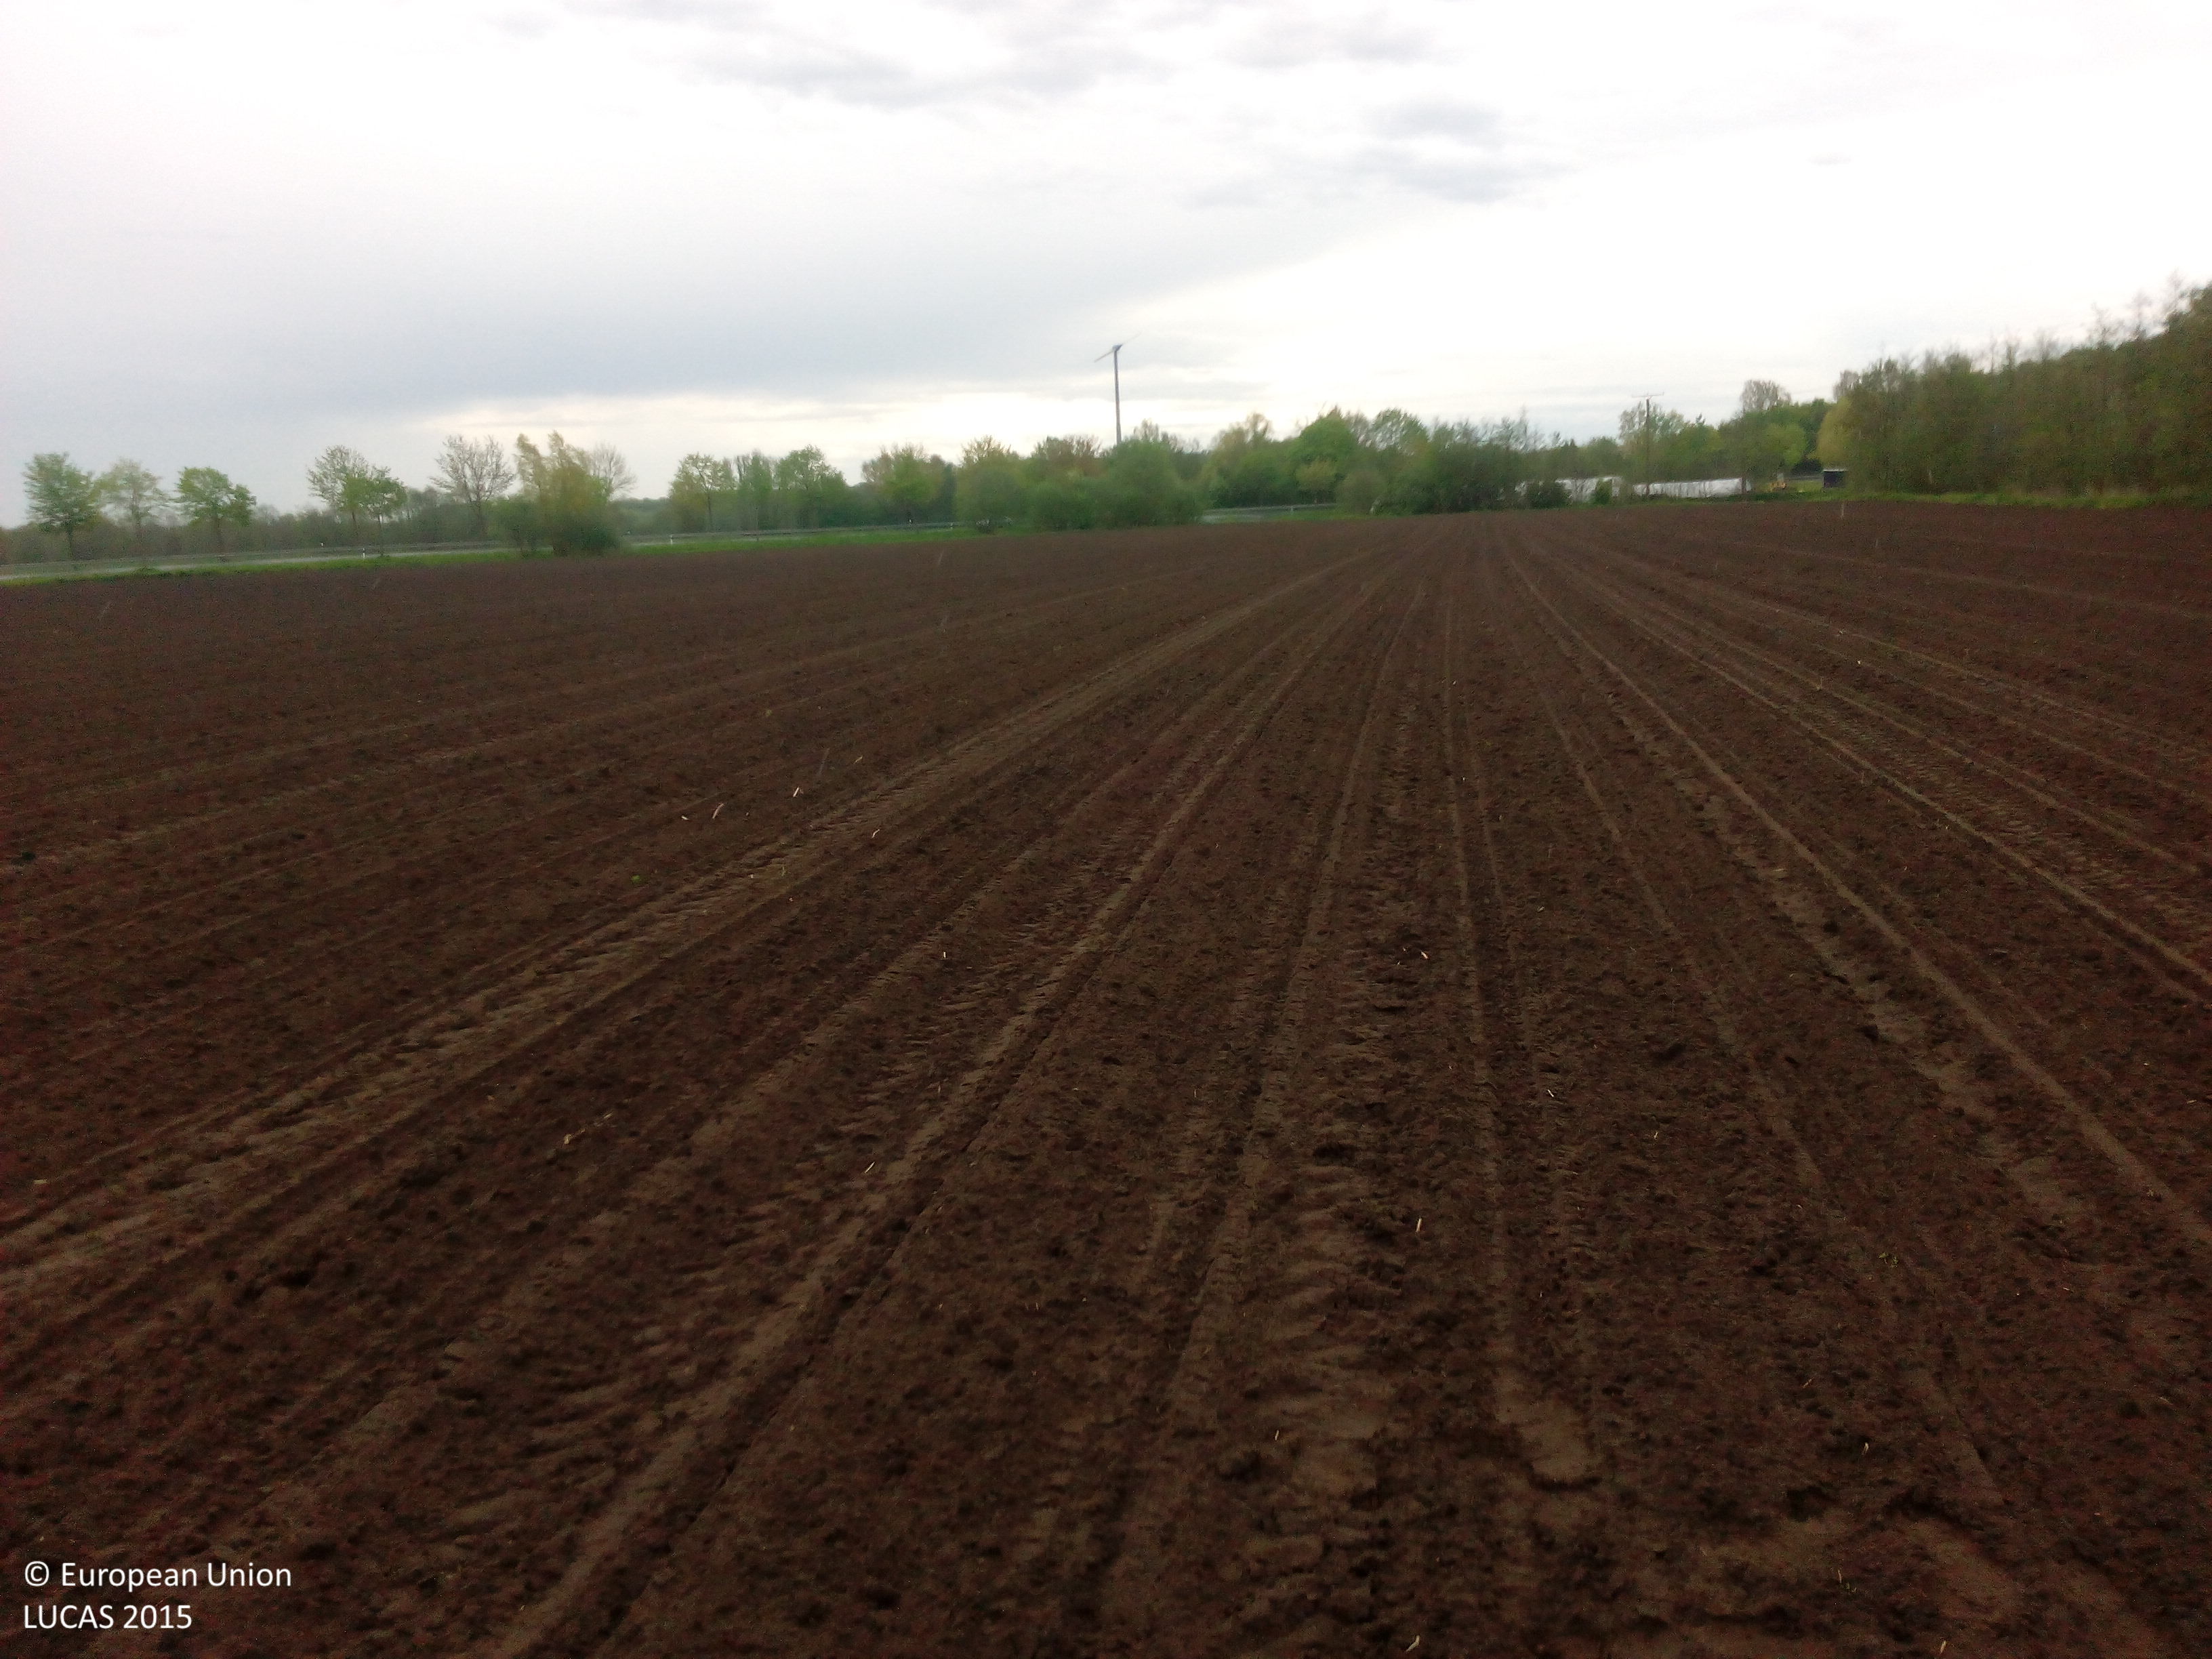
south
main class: Cropland
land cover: Maize
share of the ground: < 10 %
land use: Agriculture (excluding fallow land and kitchen gardens)
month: May
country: DE
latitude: 51.9905
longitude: 7.4518
